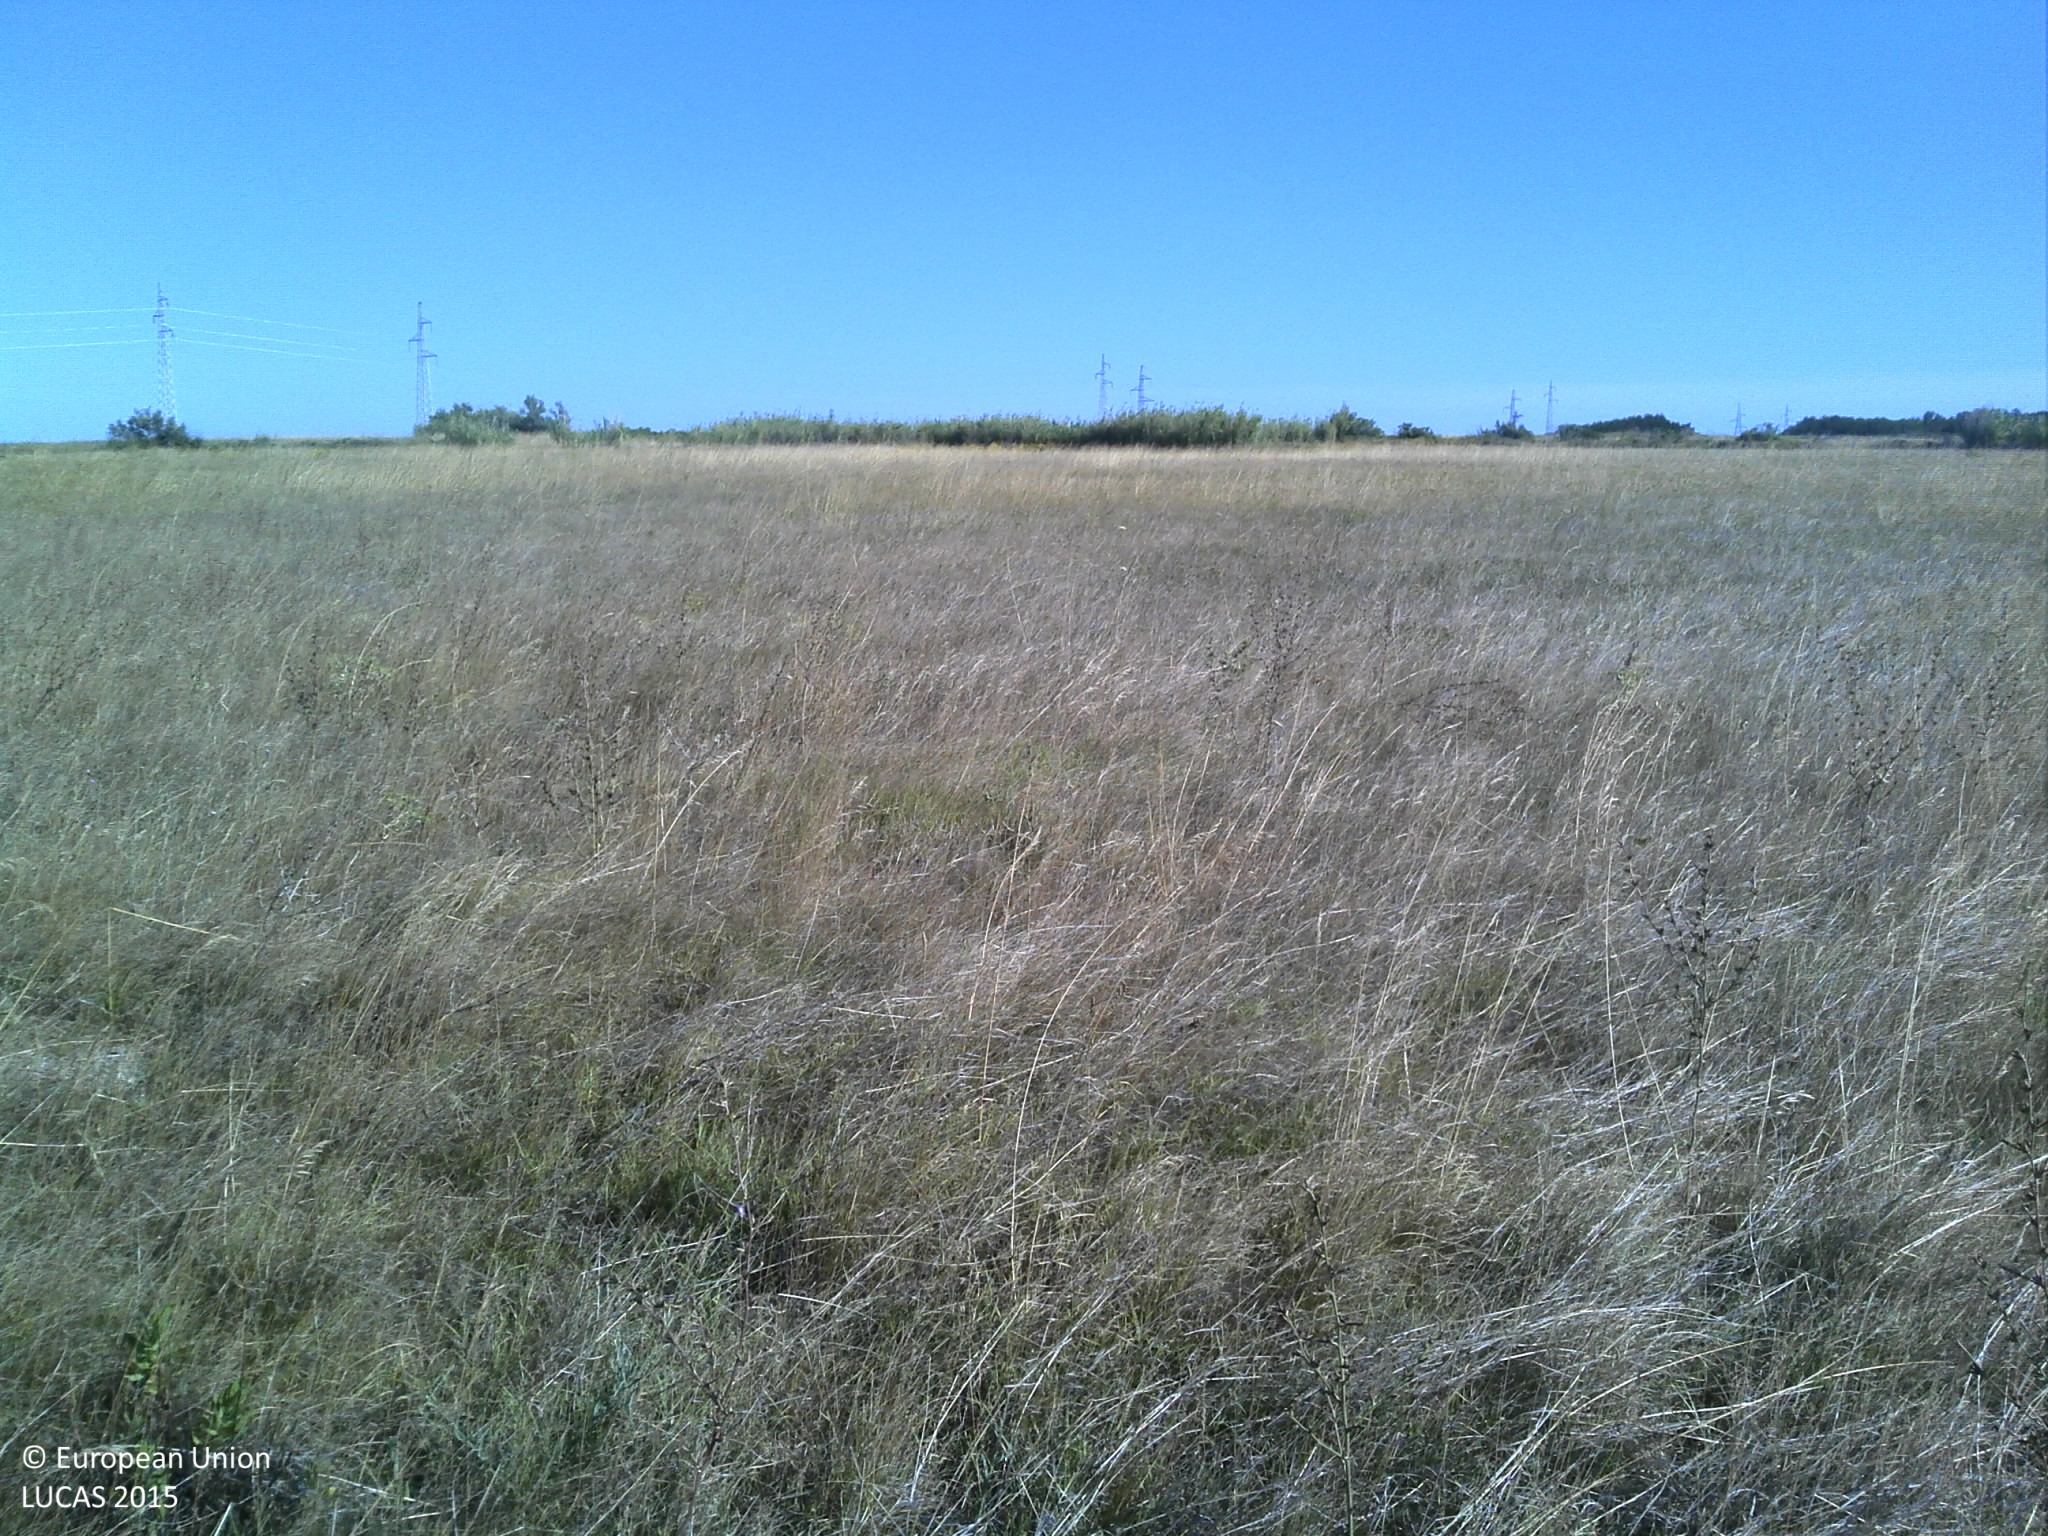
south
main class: Grassland
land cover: Grassland without tree/shrub cover
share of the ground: > 75 %
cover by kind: herbaceous plants 90 %, shrubs 5 %, consolidated bare surface 5 %
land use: Semi-natural and natural areas not in use
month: July
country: HR
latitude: 44.2773
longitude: 15.1420
